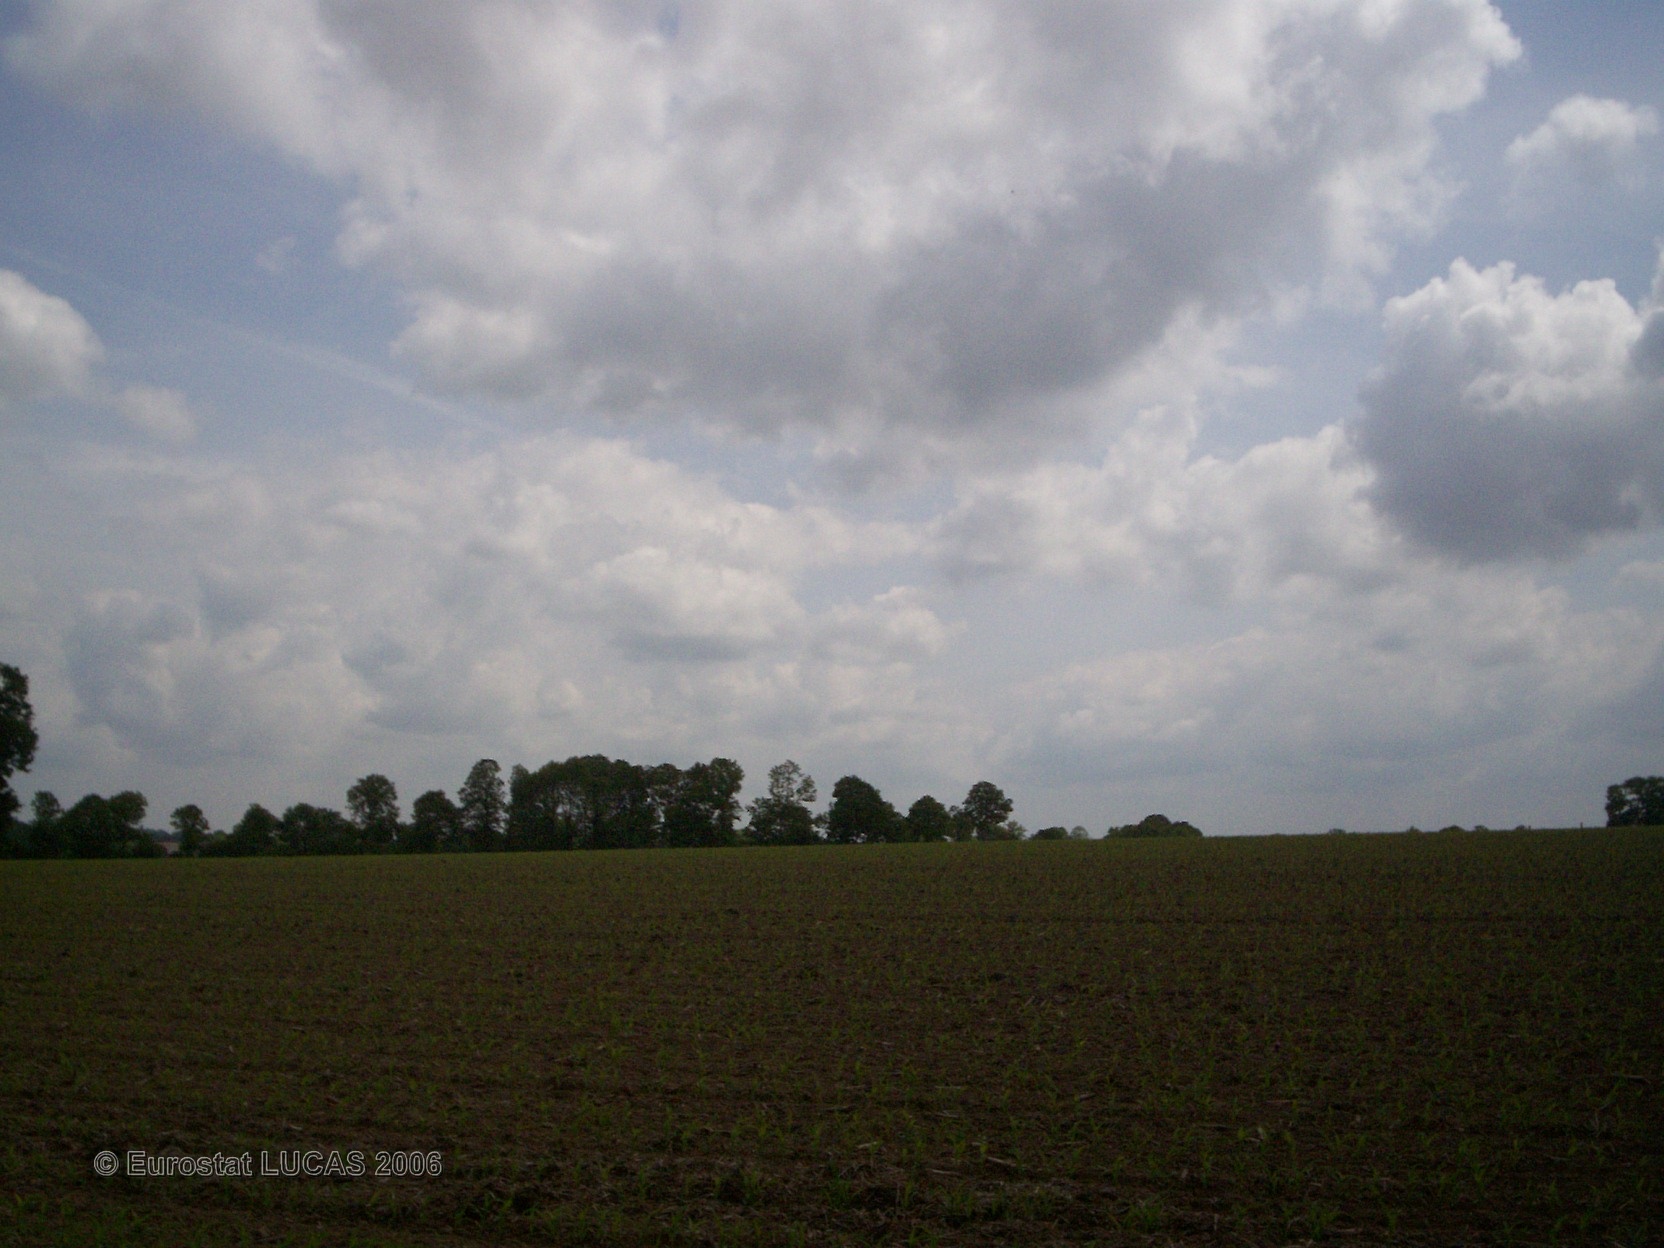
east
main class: Cropland
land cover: Maize
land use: Agriculture (excluding fallow land and kitchen gardens)
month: June
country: FR
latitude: 48.4476
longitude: -1.2241
